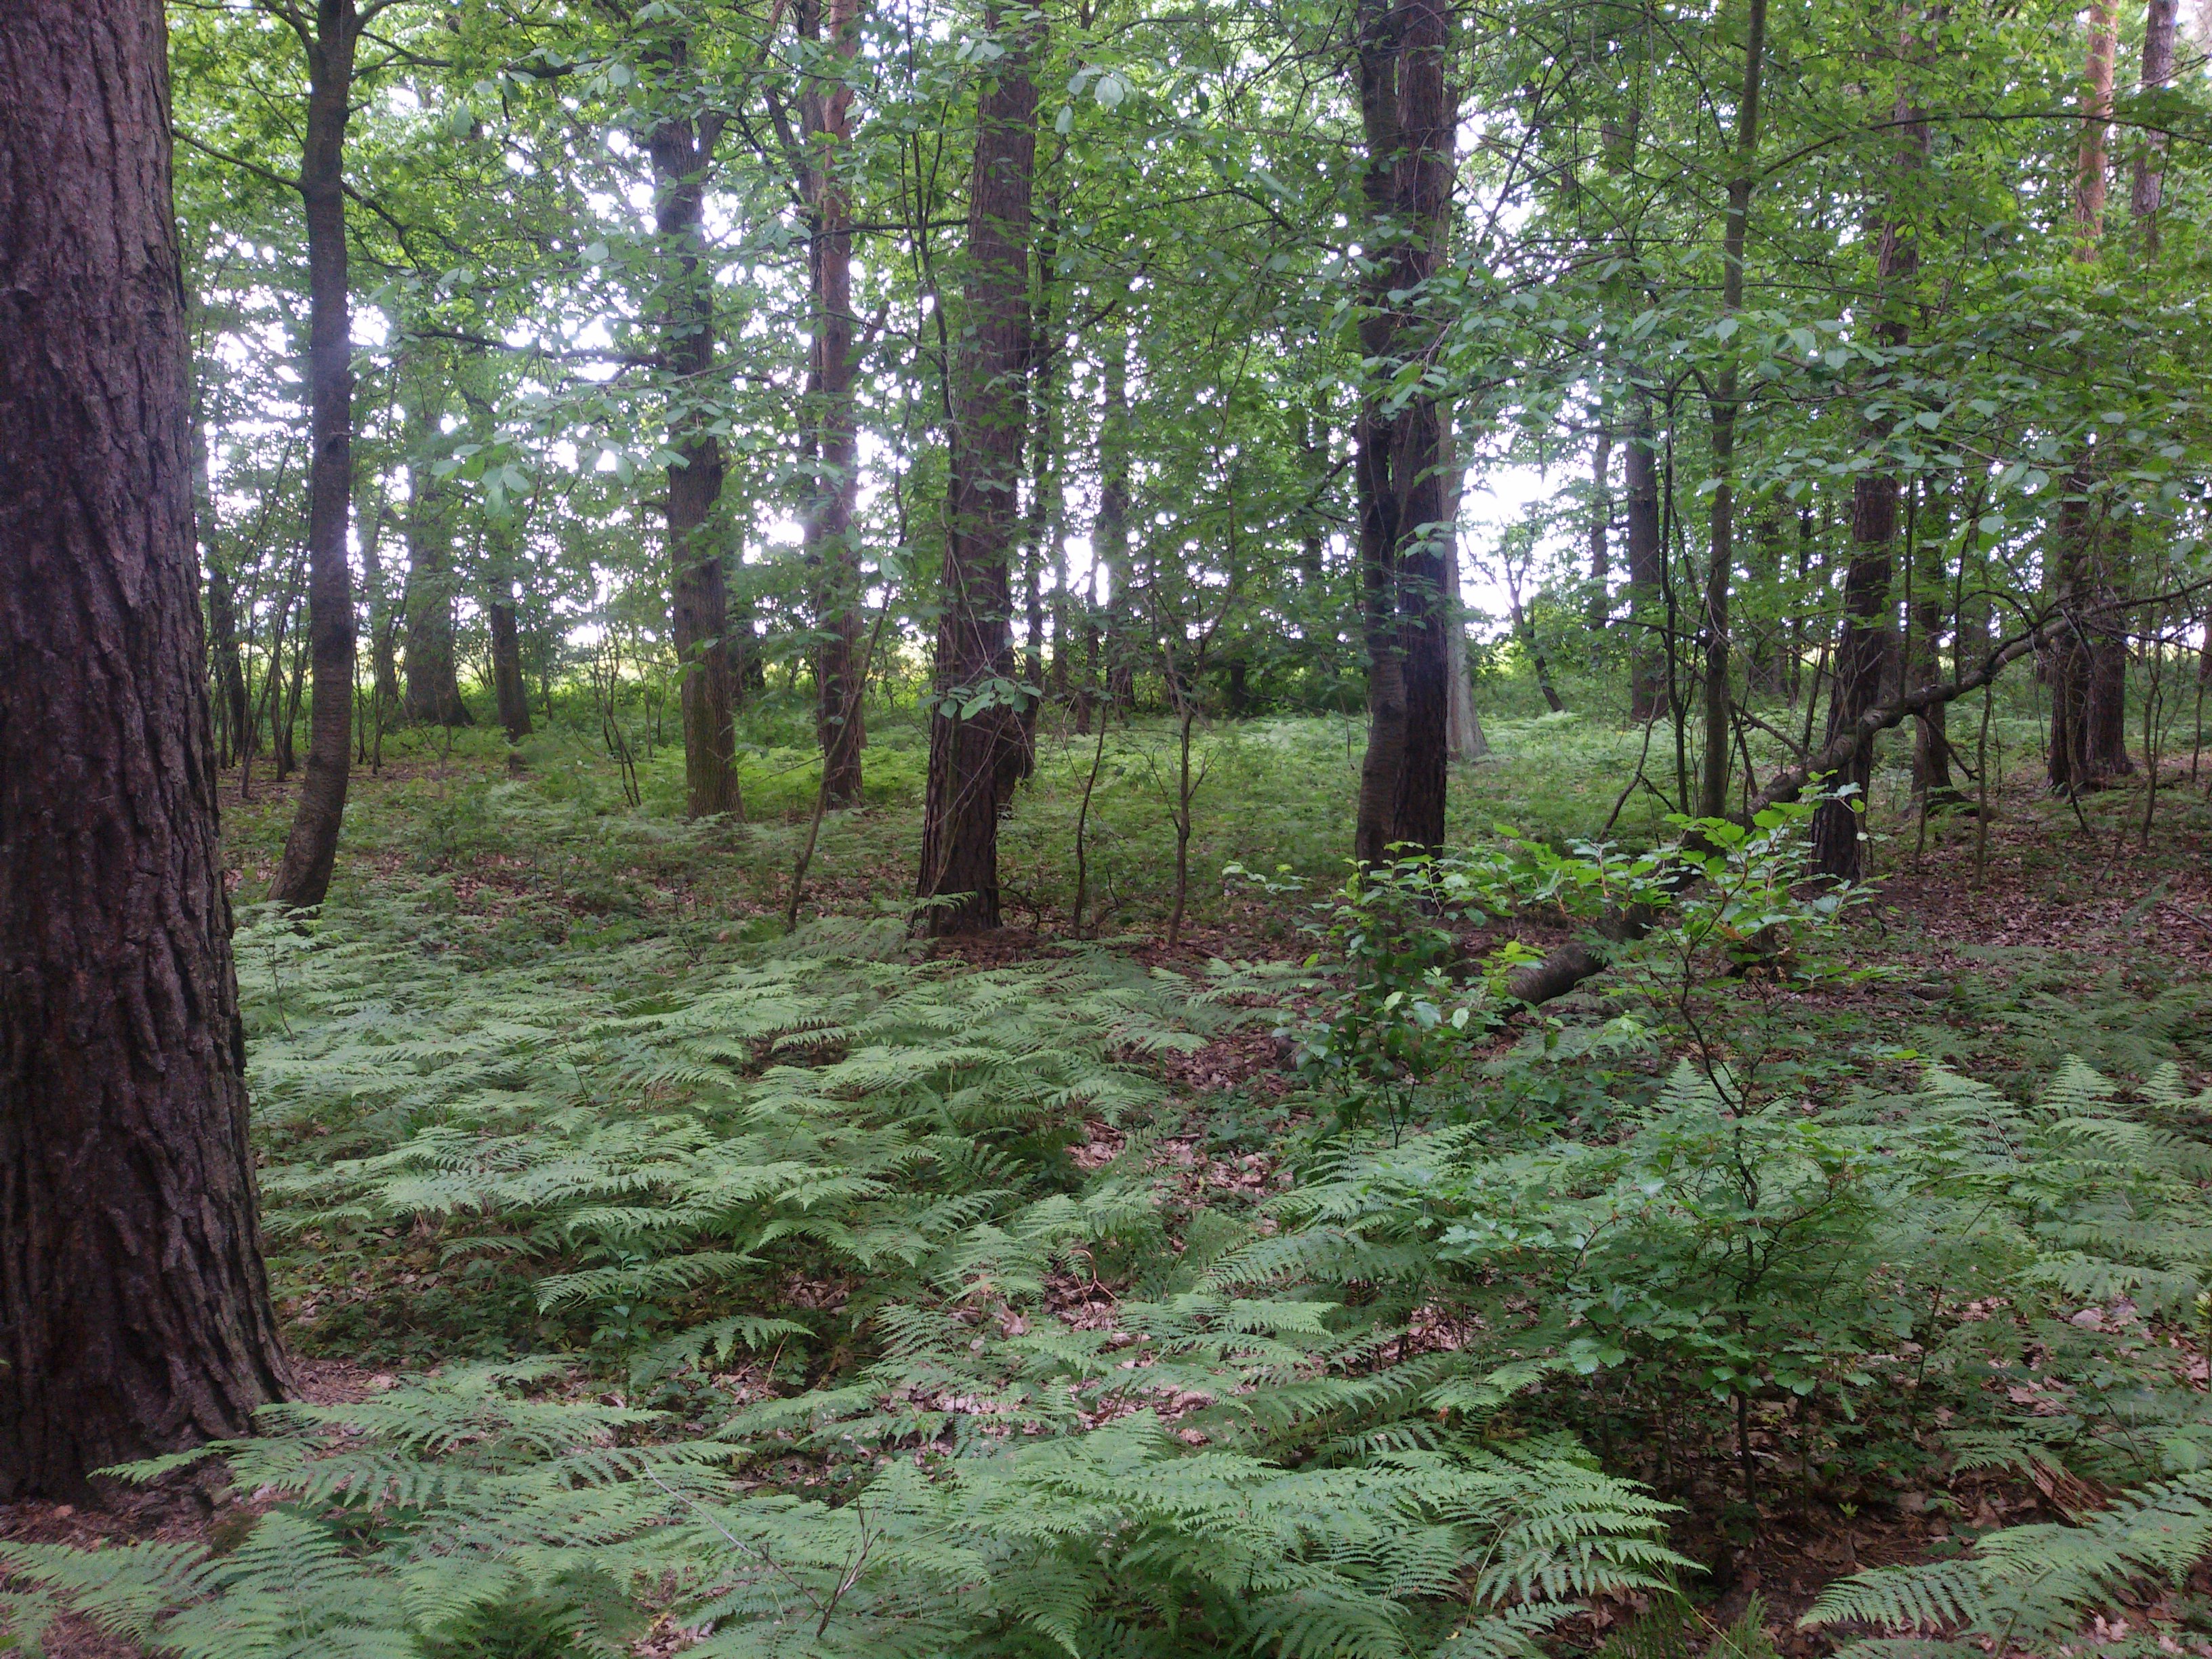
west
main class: Woodland
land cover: Pine dominated mixed woodland
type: hemiboreal forest and nemoral coniferous forest and mixed broadleaved-coniferous forest
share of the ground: > 75 %
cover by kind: coniferous forest trees 60 %, broadleaved forest trees 30 %, herbaceous plants 5 %, lichens and mosses 5 %
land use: Forestry
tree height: > 5 m
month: May
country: PL
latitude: 50.5705
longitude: 17.1978
